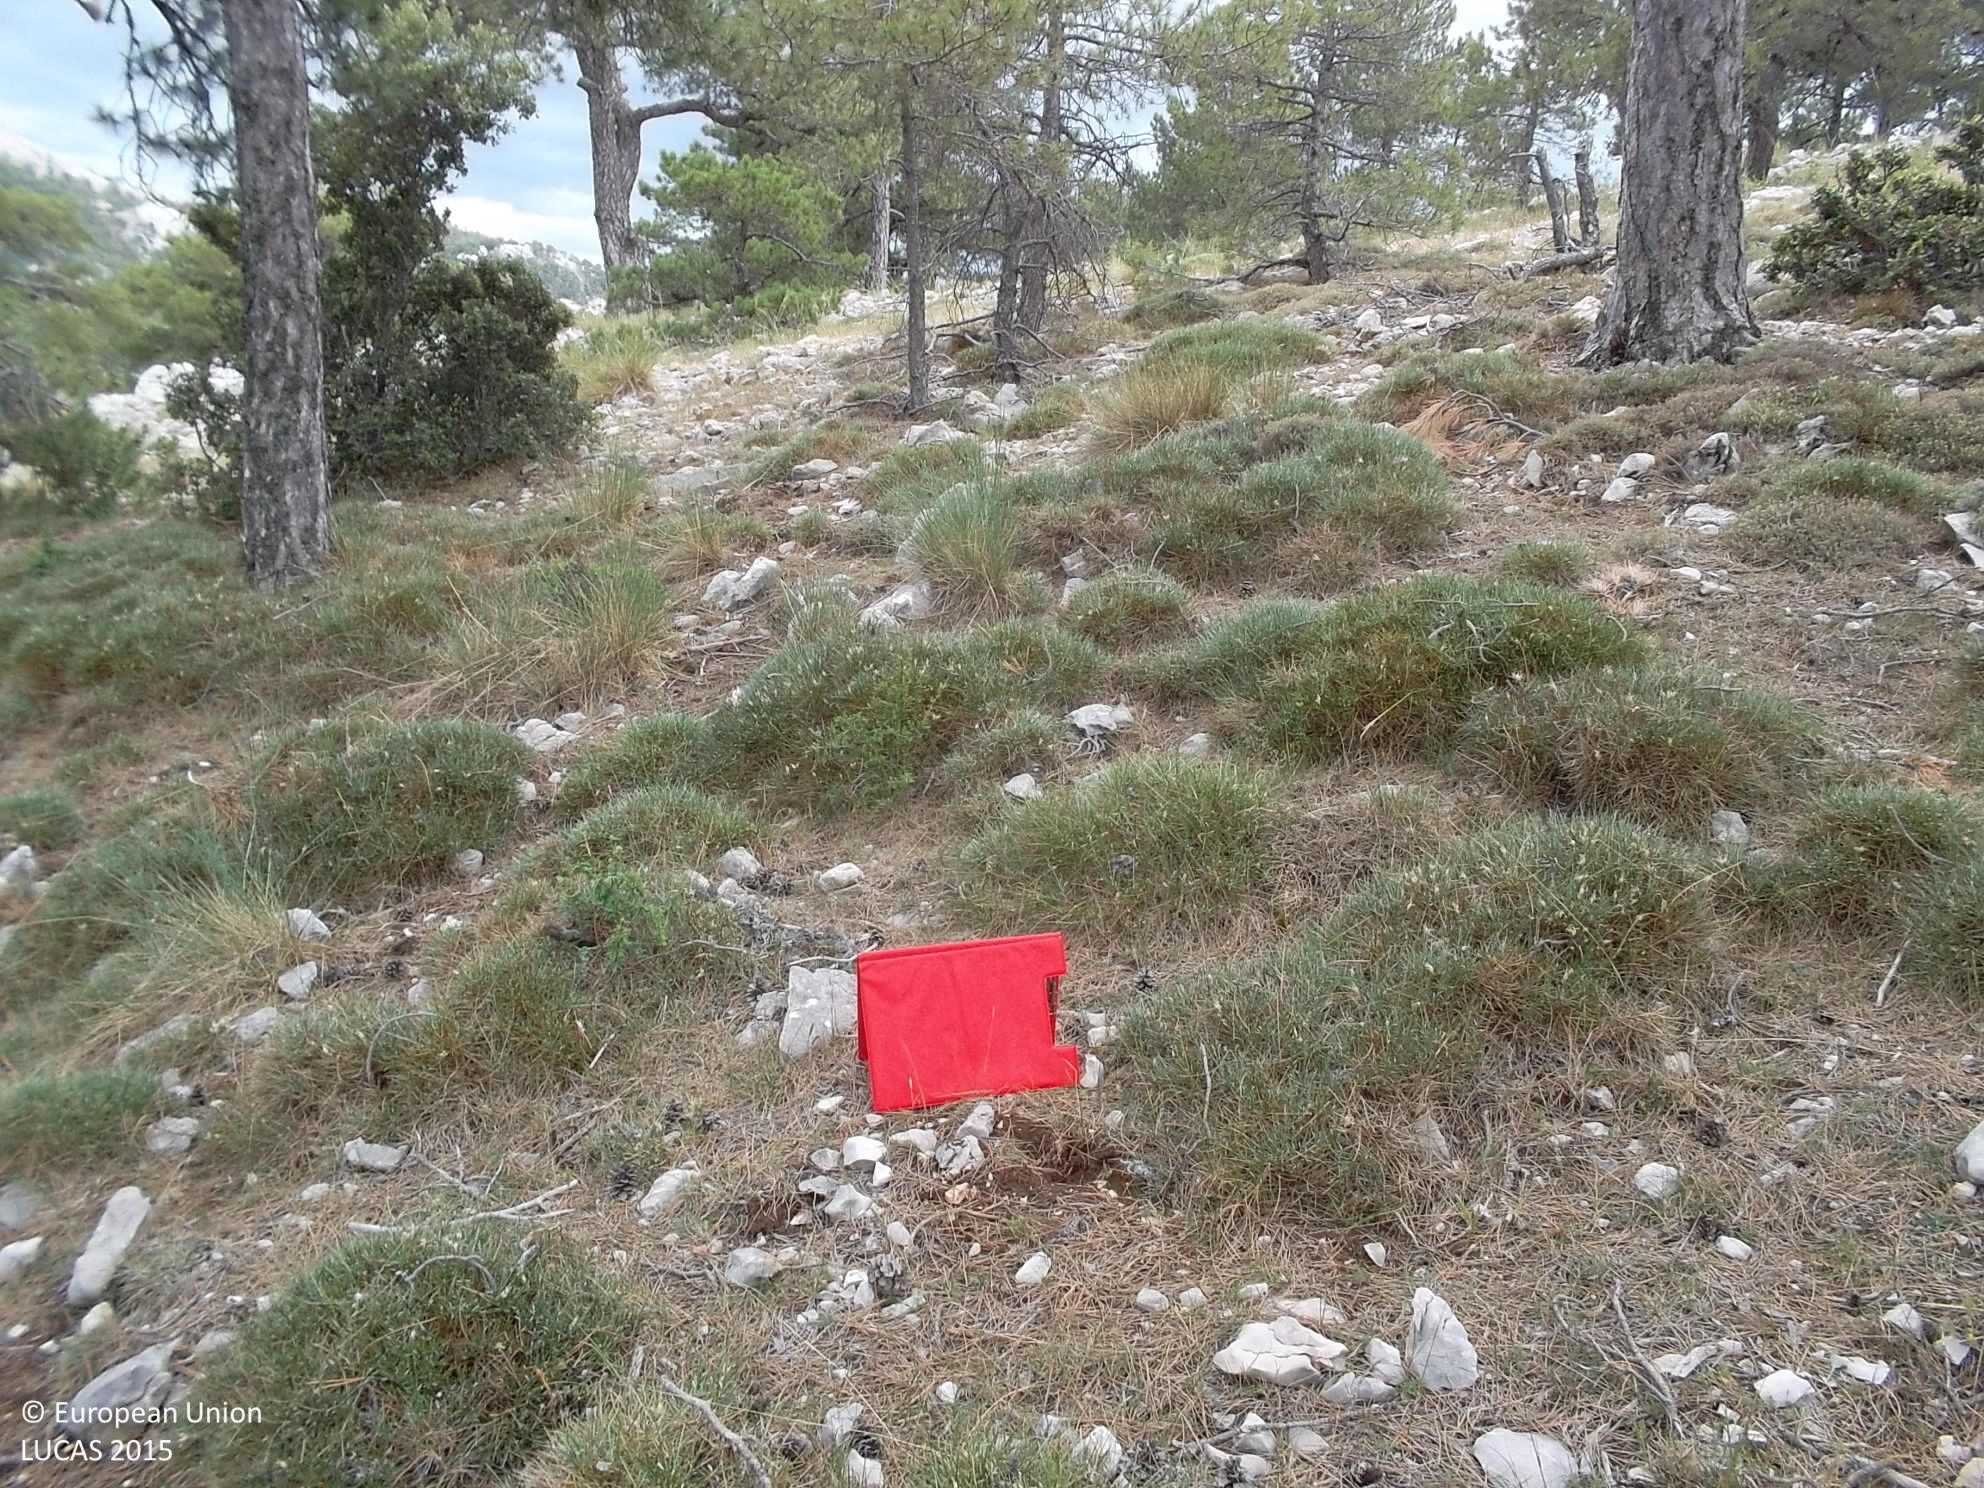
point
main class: Woodland
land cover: Pine dominated coniferous woodland
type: coniferous forest of the mediterranean region
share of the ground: 50 - 75 %
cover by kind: coniferous forest trees 60 %, herbaceous plants 20 %, consolidated bare surface 20 %
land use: Forestry
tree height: > 5 m
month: June
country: ES
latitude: 37.7902
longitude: -2.9726
